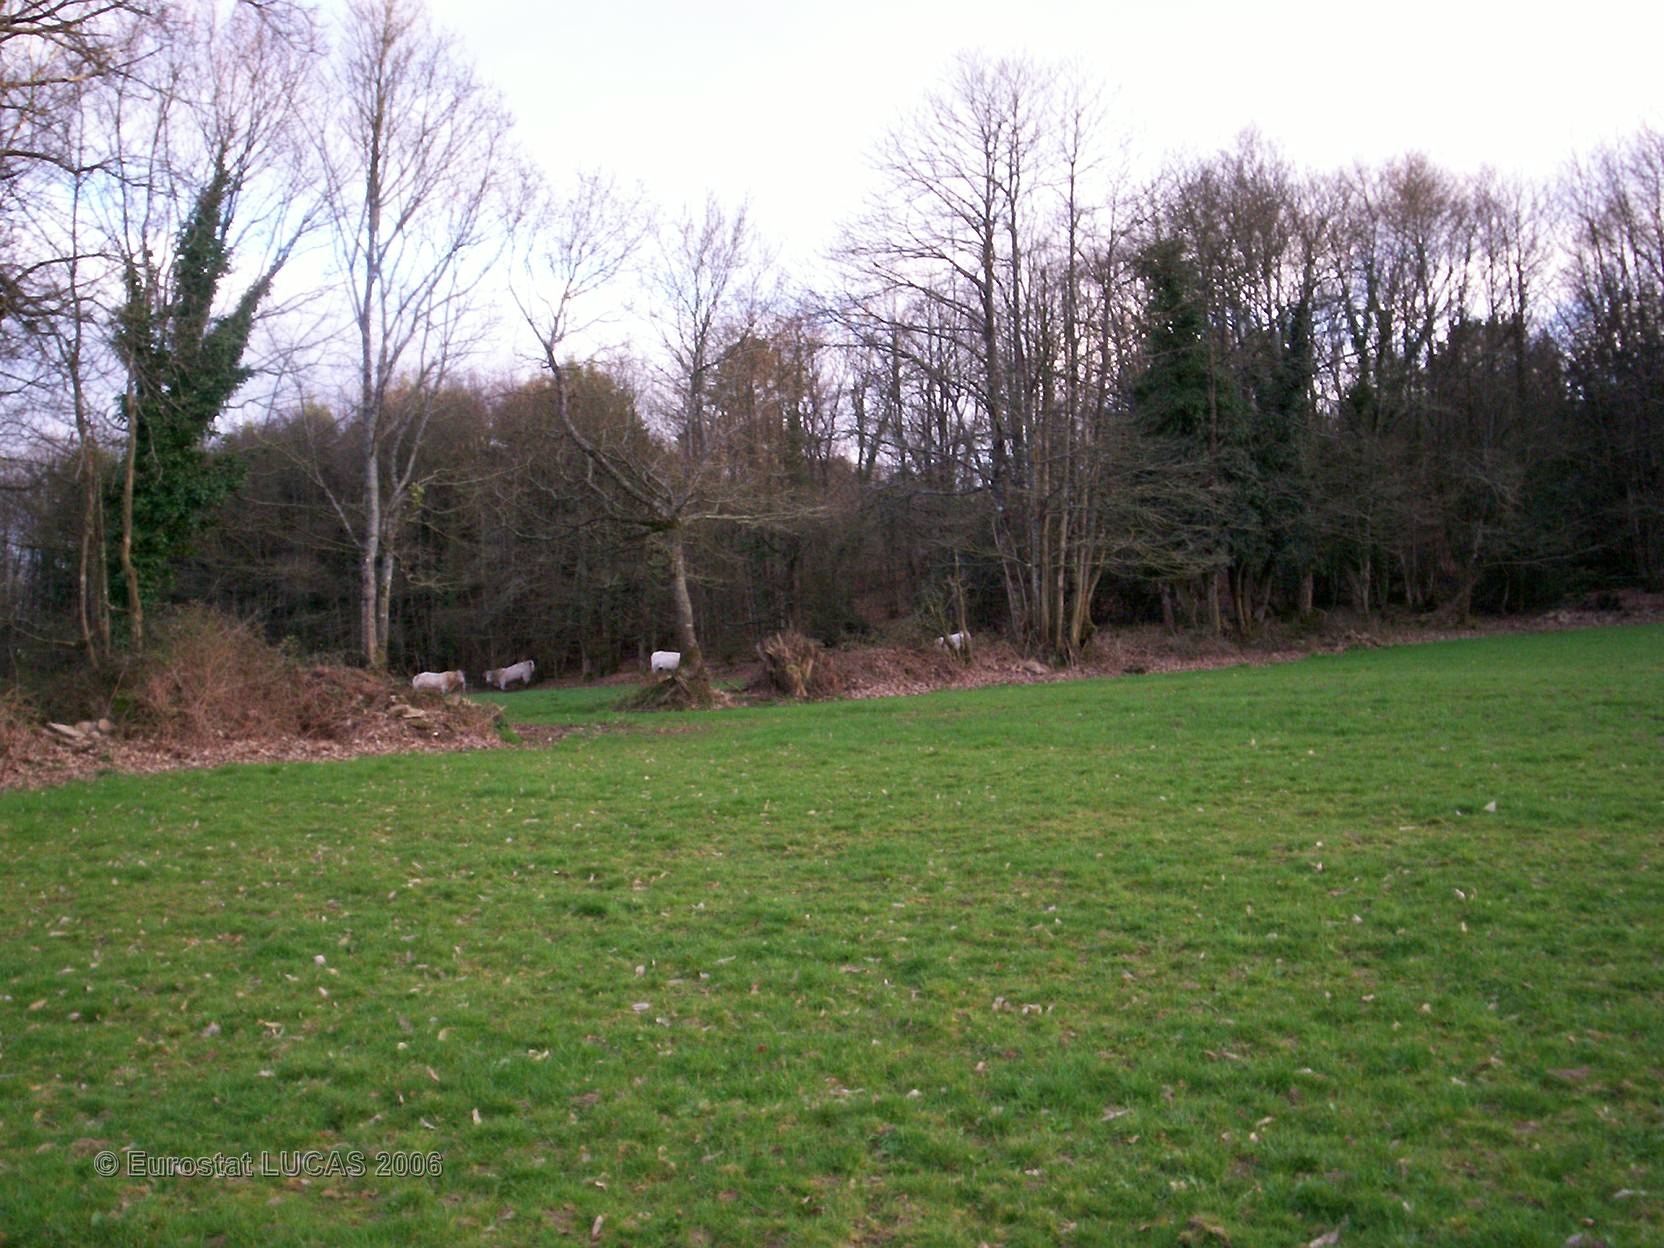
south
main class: Grassland
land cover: Grassland without tree/shrub cover
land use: Agriculture (excluding fallow land and kitchen gardens)
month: April
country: FR
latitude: 48.0237
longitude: -3.5262
